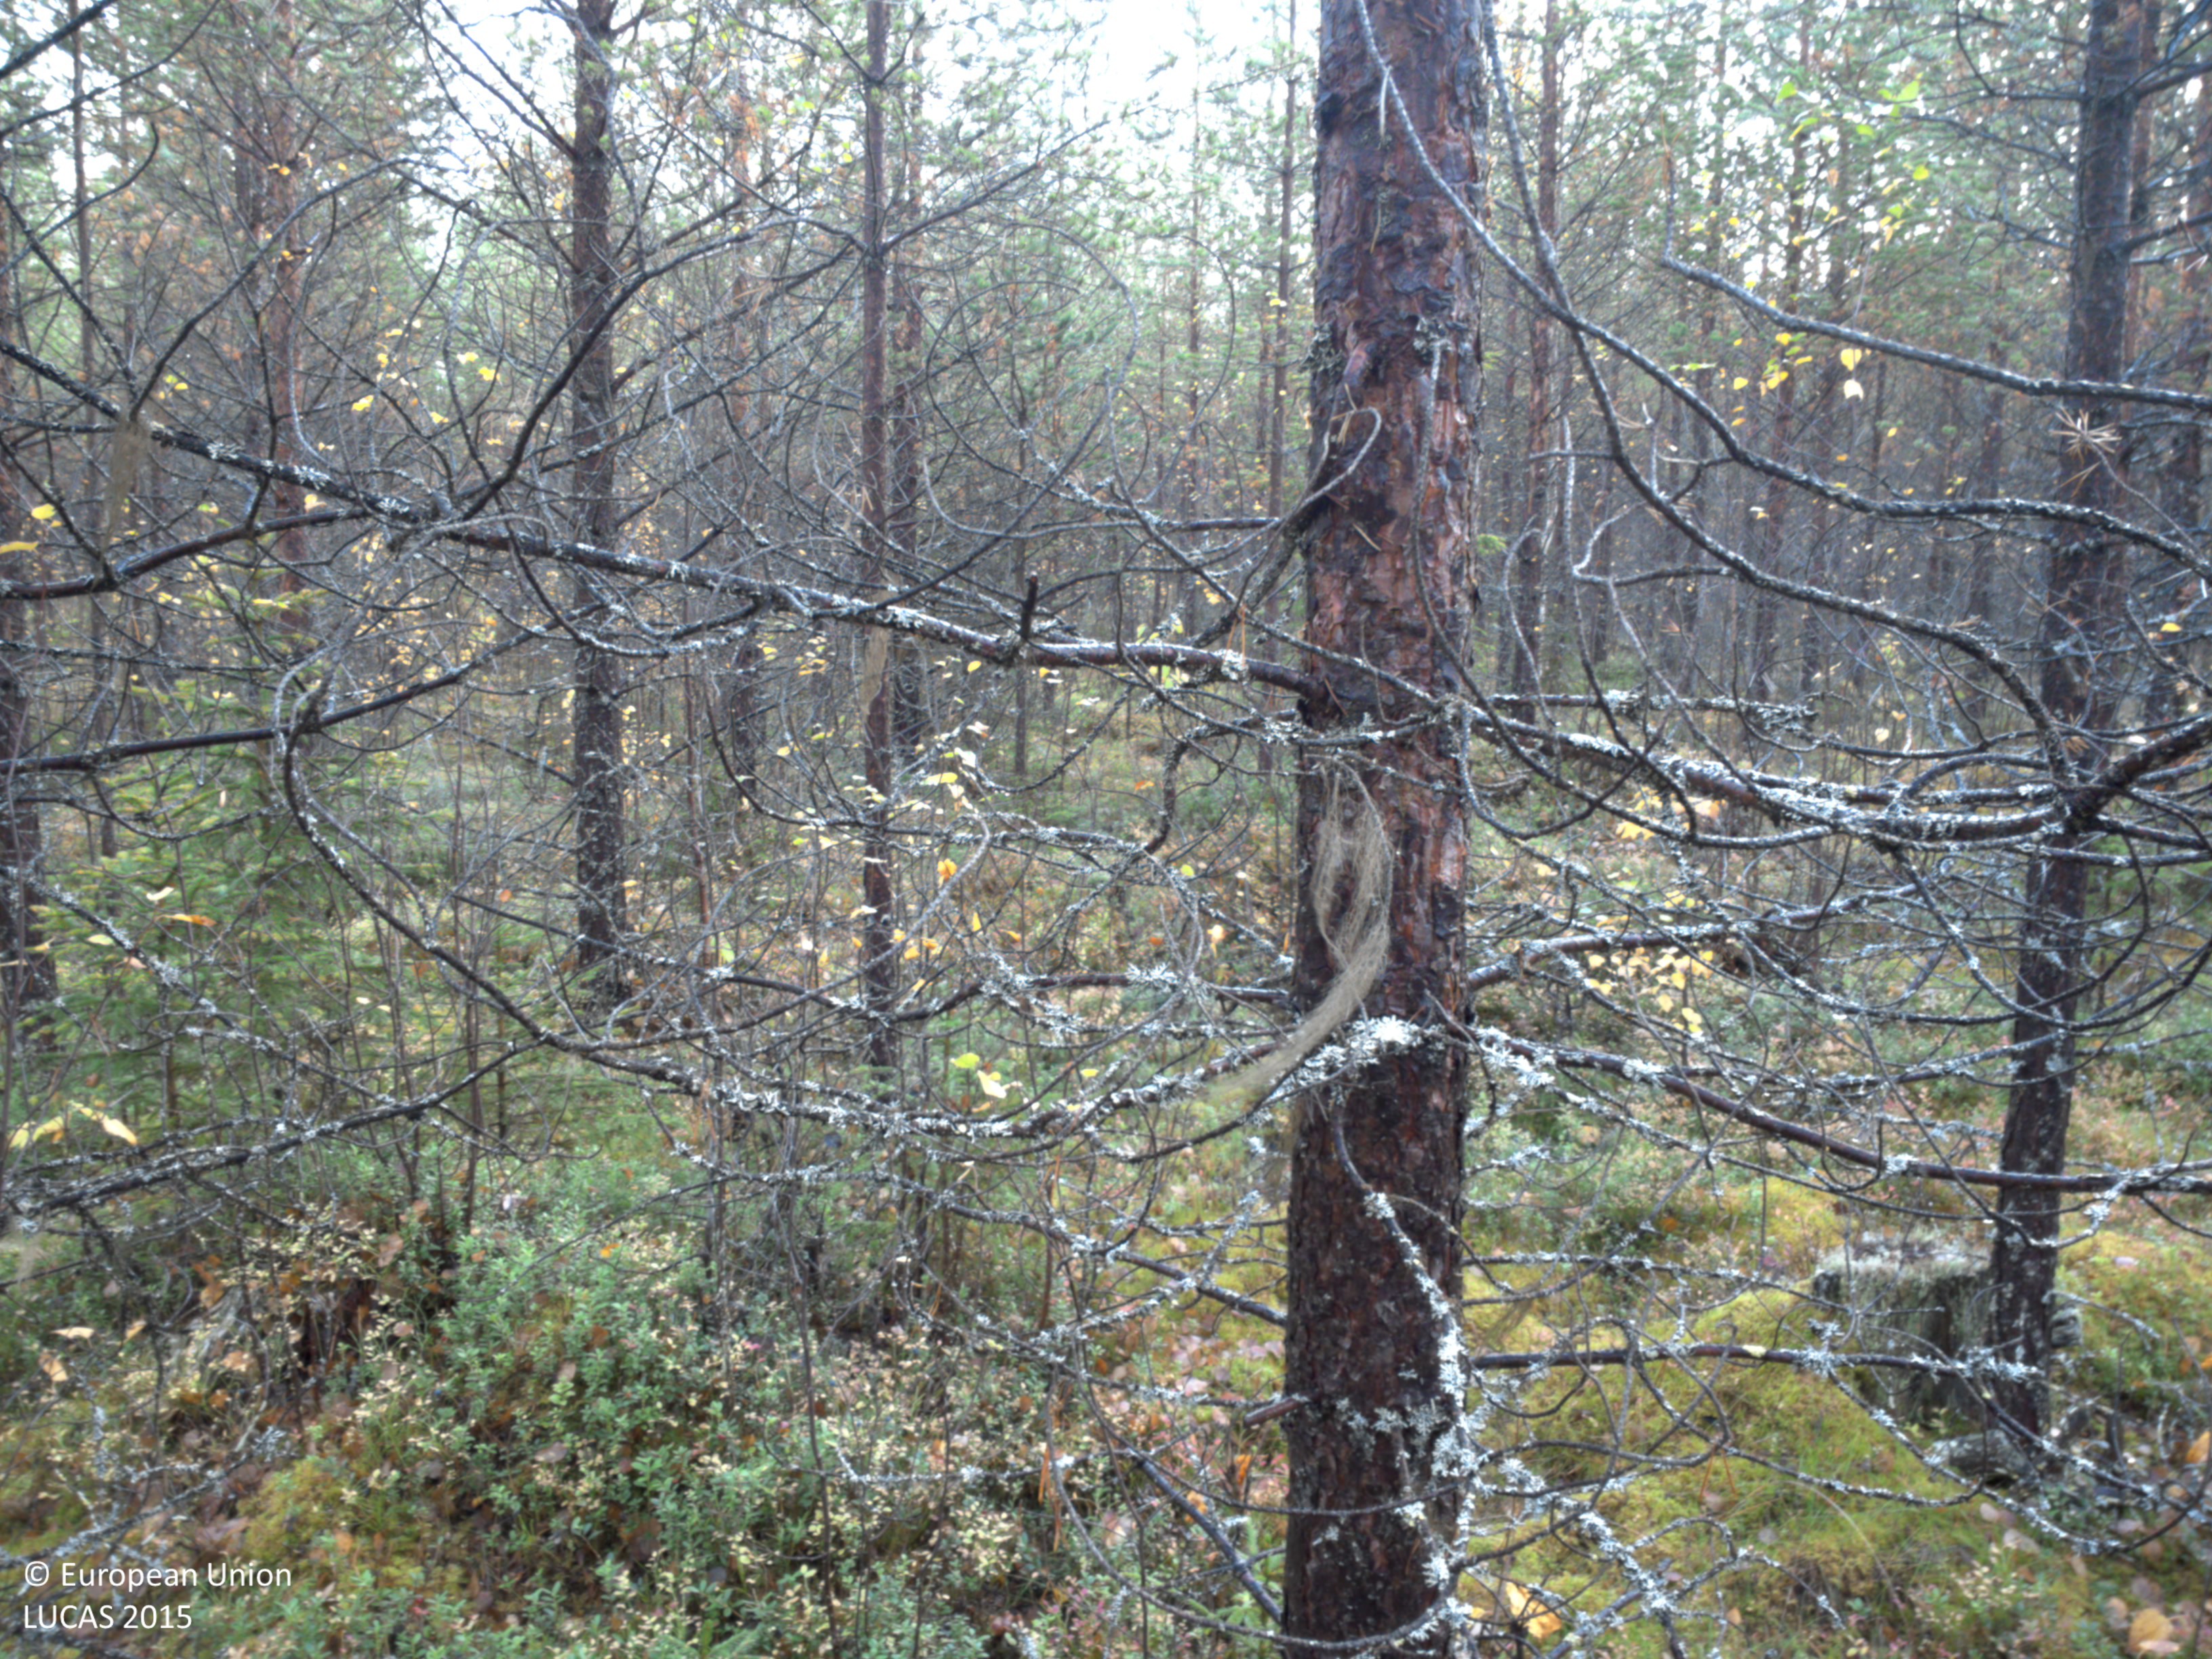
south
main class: Woodland
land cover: Pine dominated coniferous woodland
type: boreal forest
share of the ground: > 75 %
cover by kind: coniferous forest trees 75 %, shrubs 10 %, broadleaved forest trees 5 %, herbaceous plants 5 %, lichens and mosses 5 %
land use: Forestry
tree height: > 5 m
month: September
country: SE
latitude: 64.7215
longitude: 19.0560
